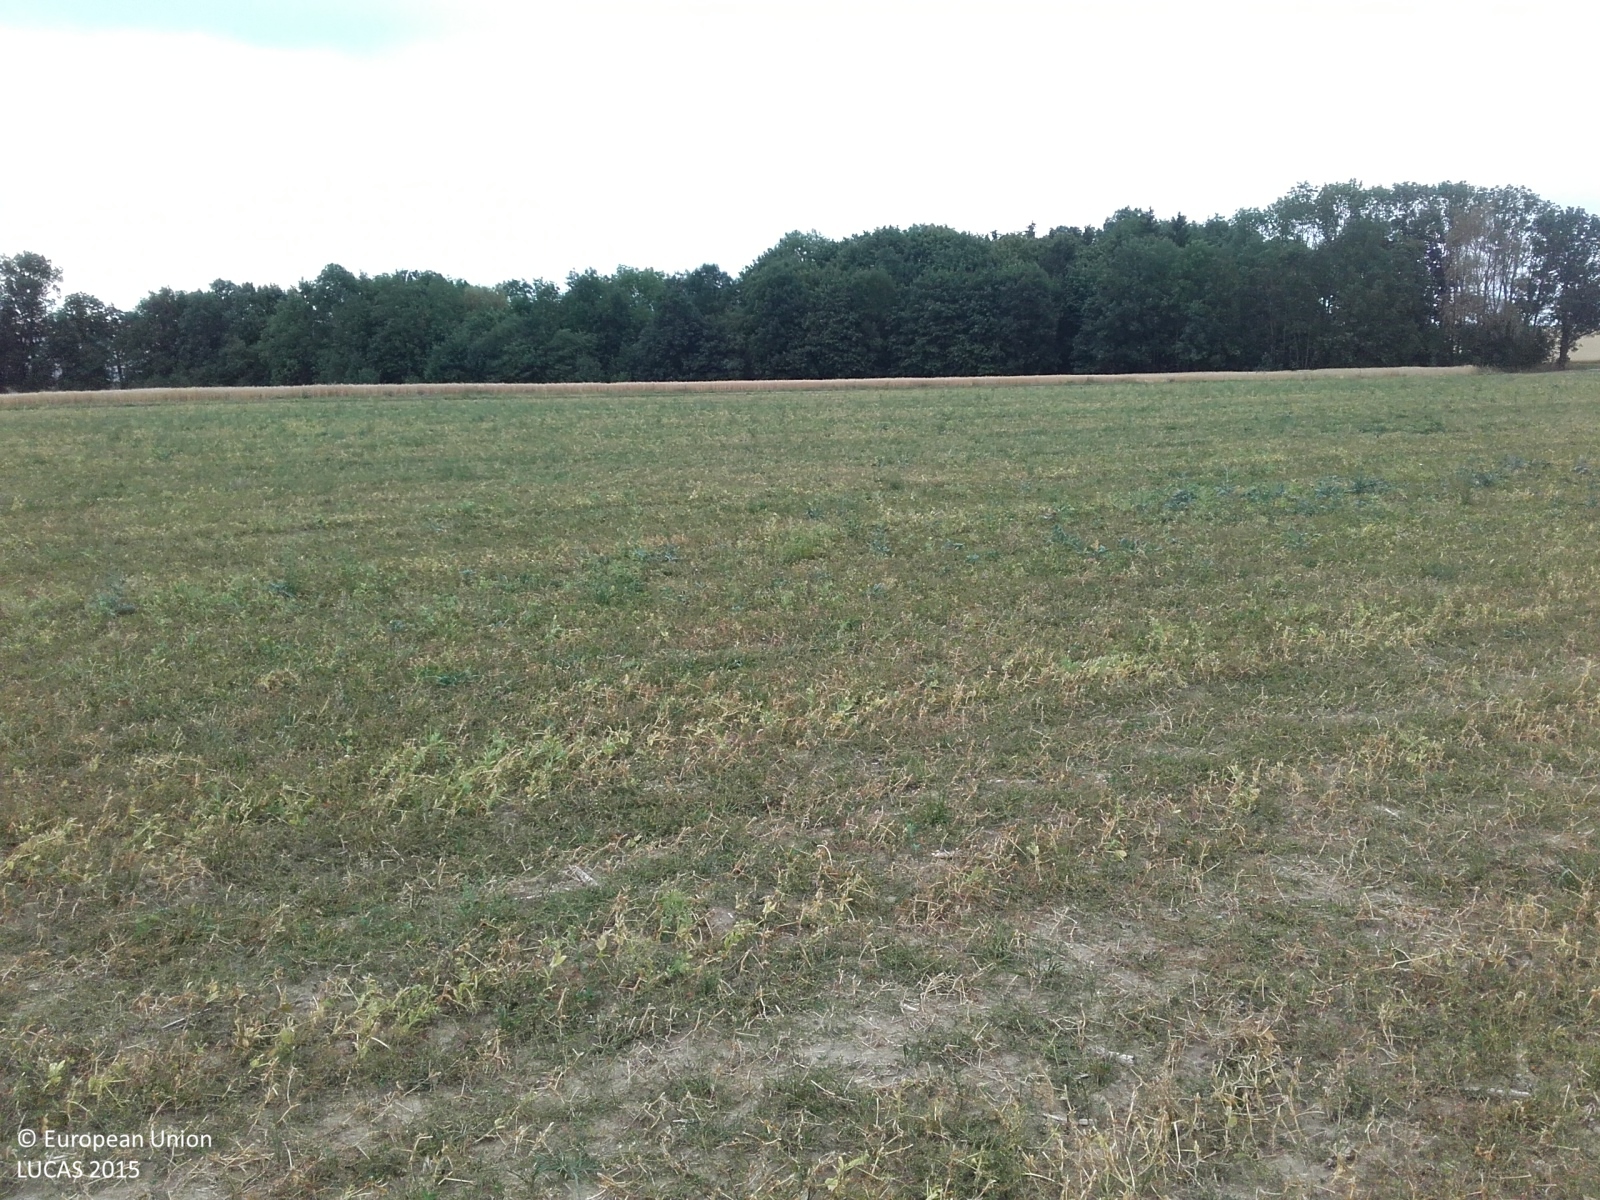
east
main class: Cropland
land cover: Dry pulses
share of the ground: > 75 %
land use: Agriculture (excluding fallow land and kitchen gardens)
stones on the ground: < 10 %
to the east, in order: Dry pulses; Grass margins; Tracks; Grass margins; Common wheat; Broadleaved woodland; Tracks; Broadleaved woodland; Grass margins; Paved roads, cycling and walking lanes; Grass margins; Fences; Apple fruit
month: August
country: CZ
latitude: 49.7414
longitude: 16.2648
